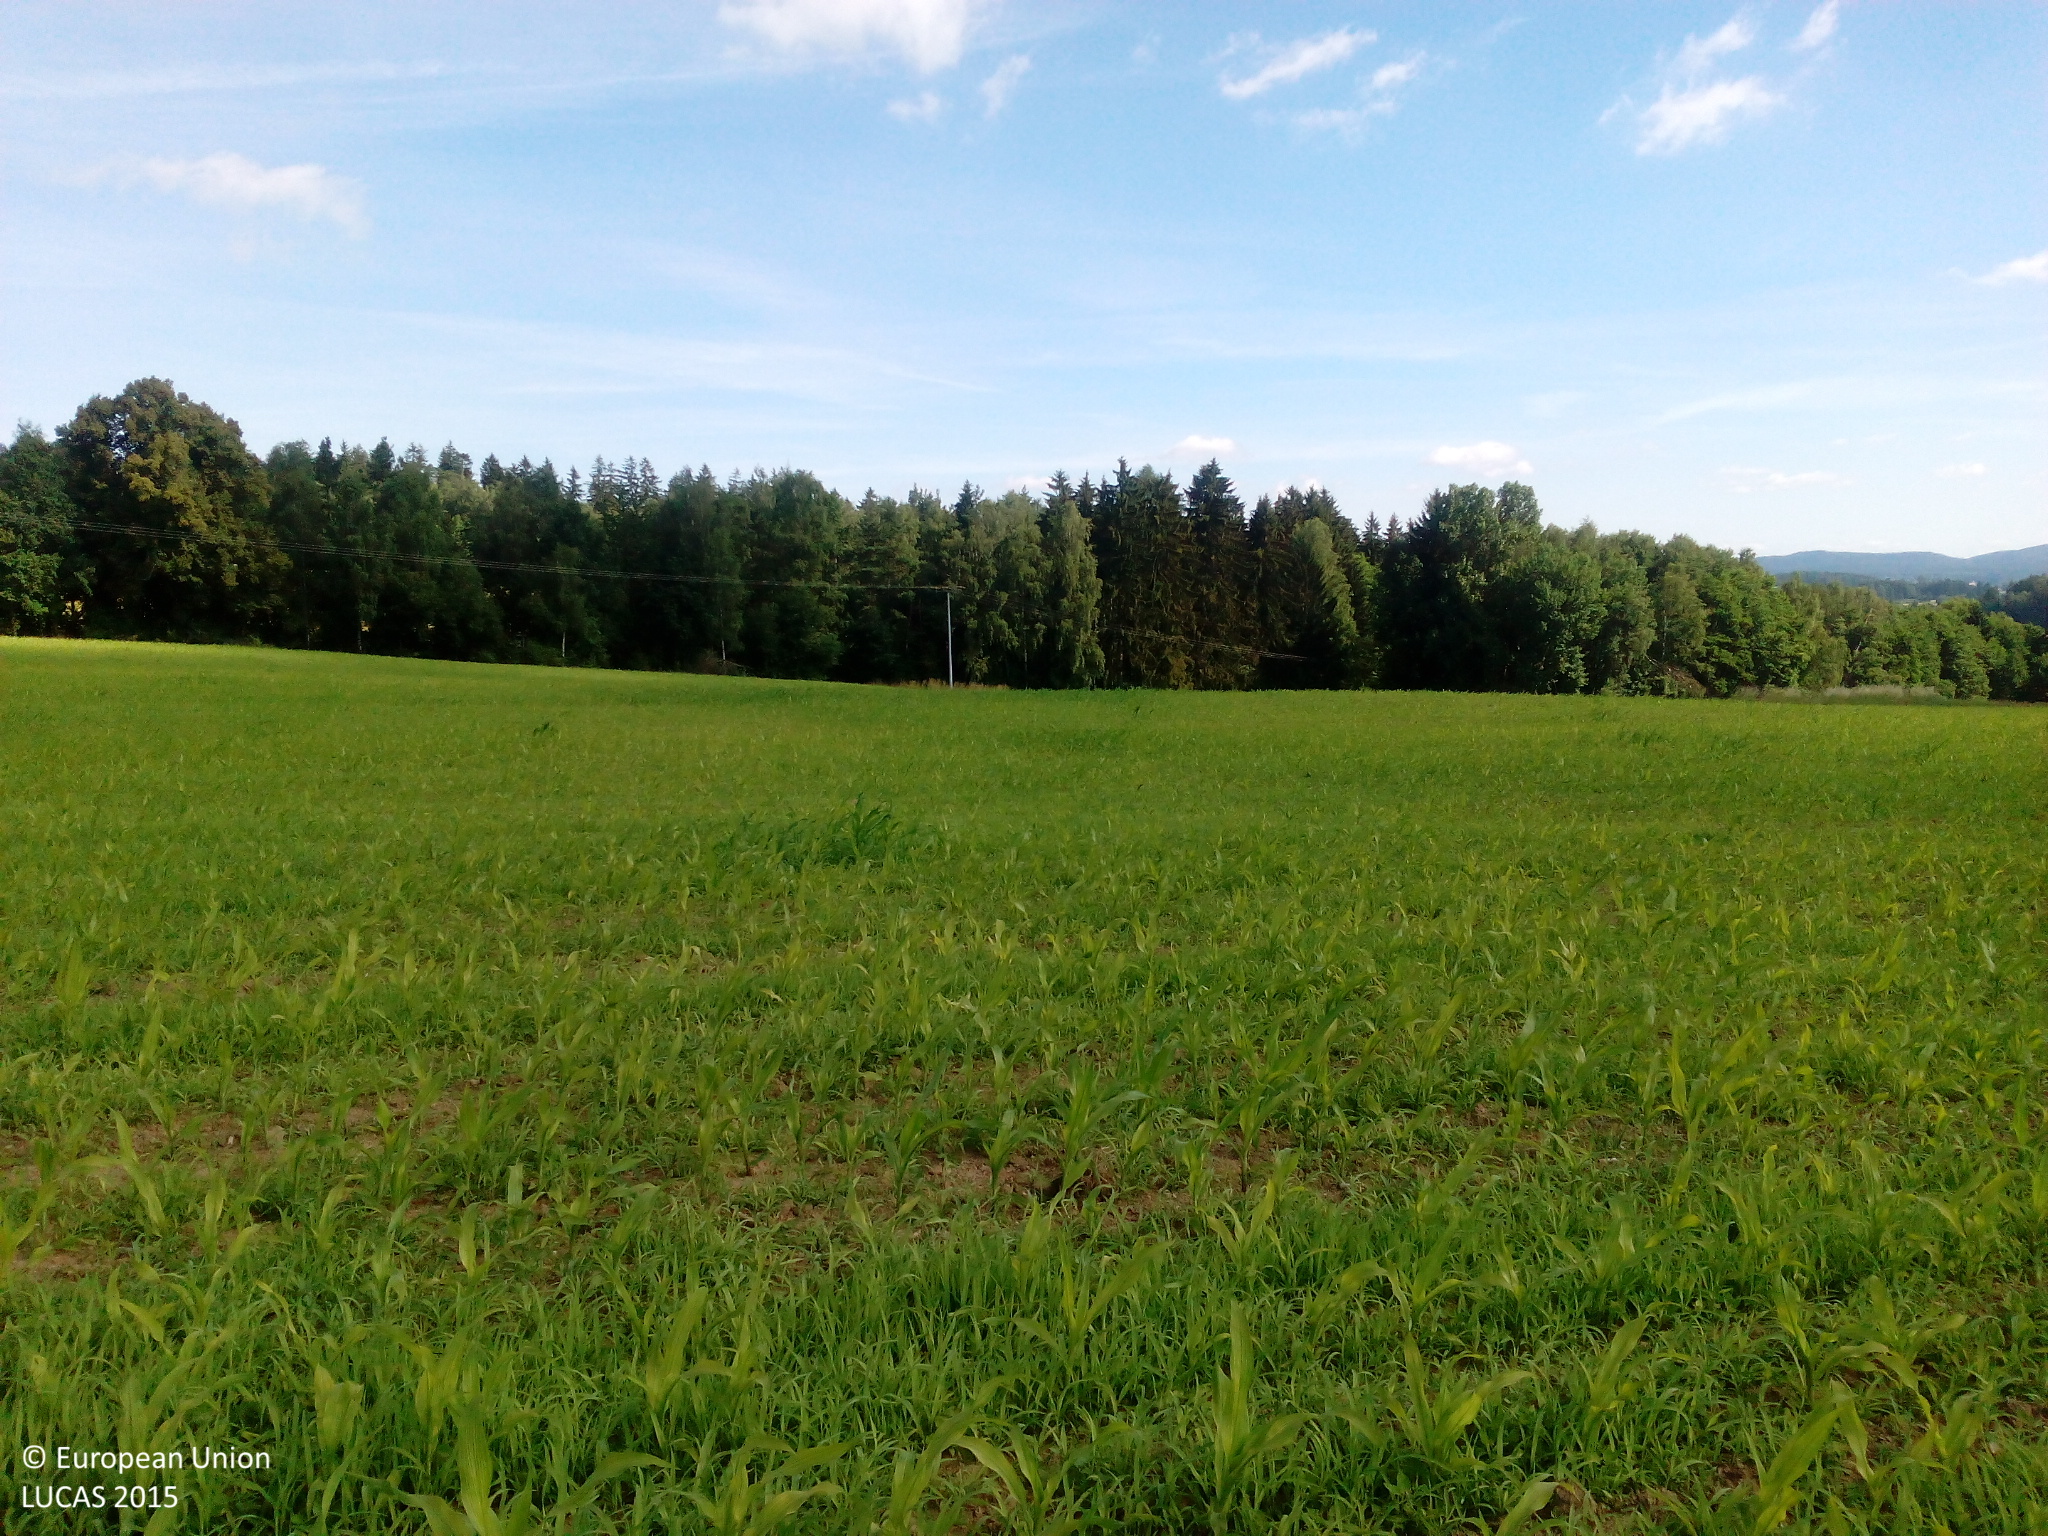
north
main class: Cropland
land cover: Maize
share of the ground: 10 - 25 %
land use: Agriculture (excluding fallow land and kitchen gardens)
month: July
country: DE
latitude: 49.6947
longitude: 12.2315
